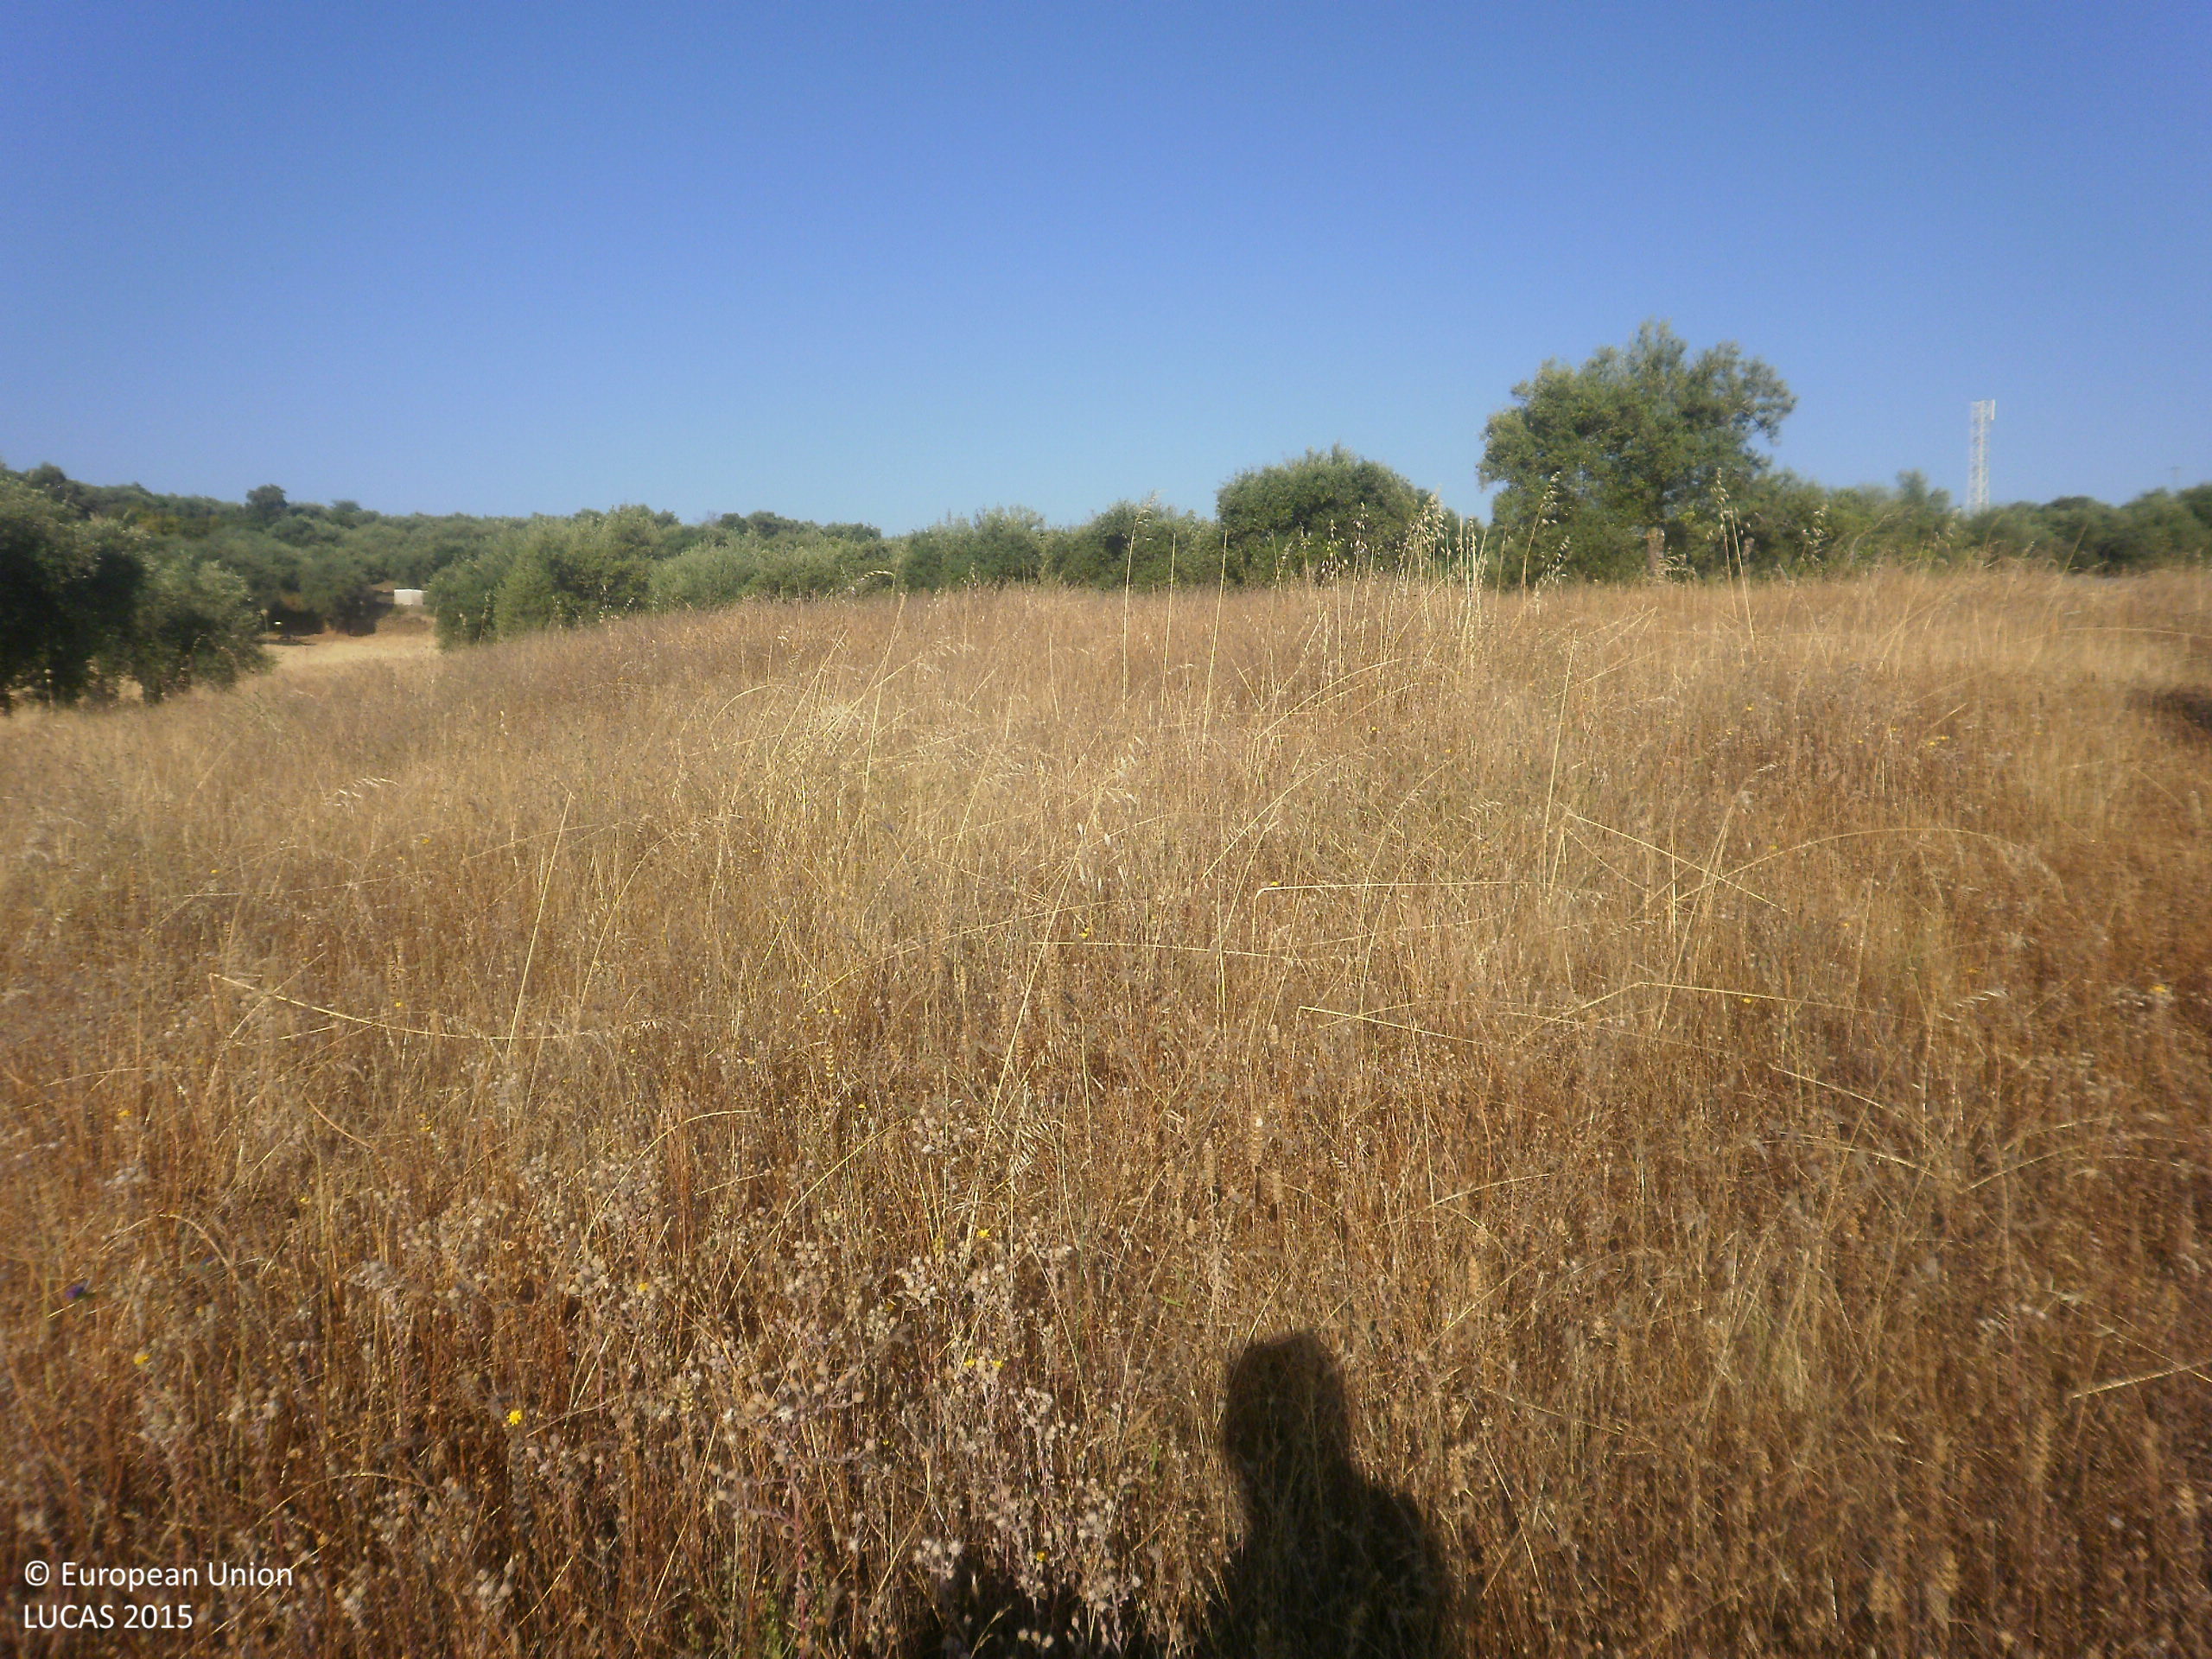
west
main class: Cropland
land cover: Olive groves
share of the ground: 50 - 75 %
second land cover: Grassland without tree/shrub cover
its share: 25 - 50 %
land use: Agriculture (excluding fallow land and kitchen gardens)
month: June
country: ES
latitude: 39.2513
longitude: -6.0371
